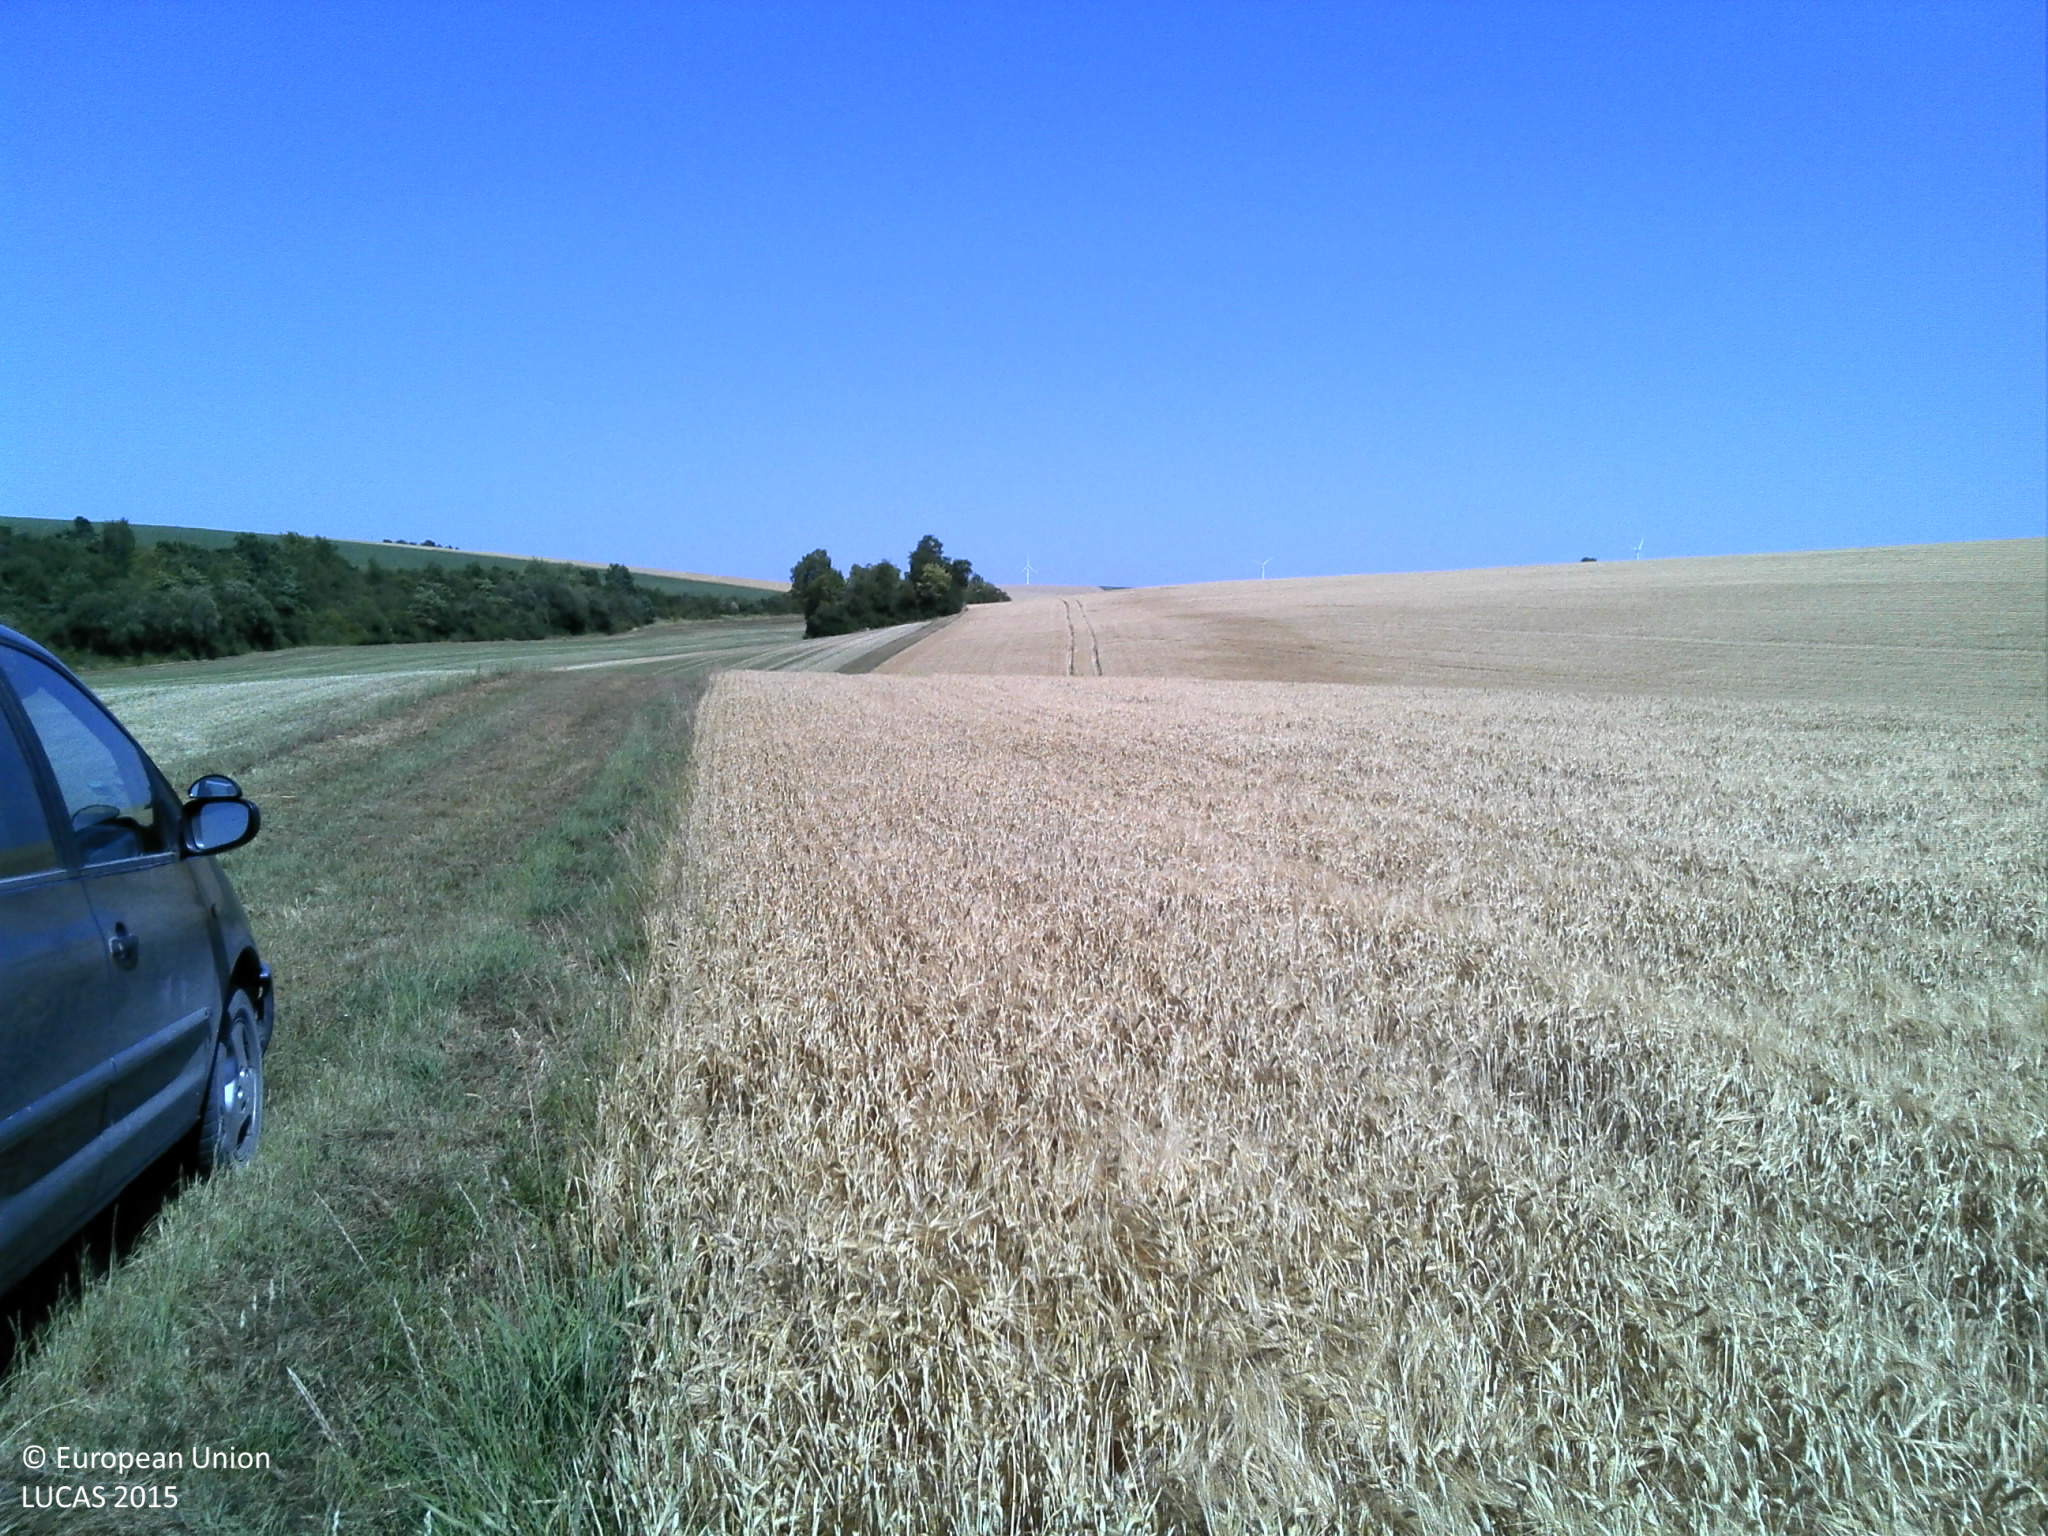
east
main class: Cropland
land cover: Barley
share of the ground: > 75 %
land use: Agriculture (excluding fallow land and kitchen gardens)
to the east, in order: Barley
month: July
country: FR
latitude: 48.8685
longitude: 4.6394
